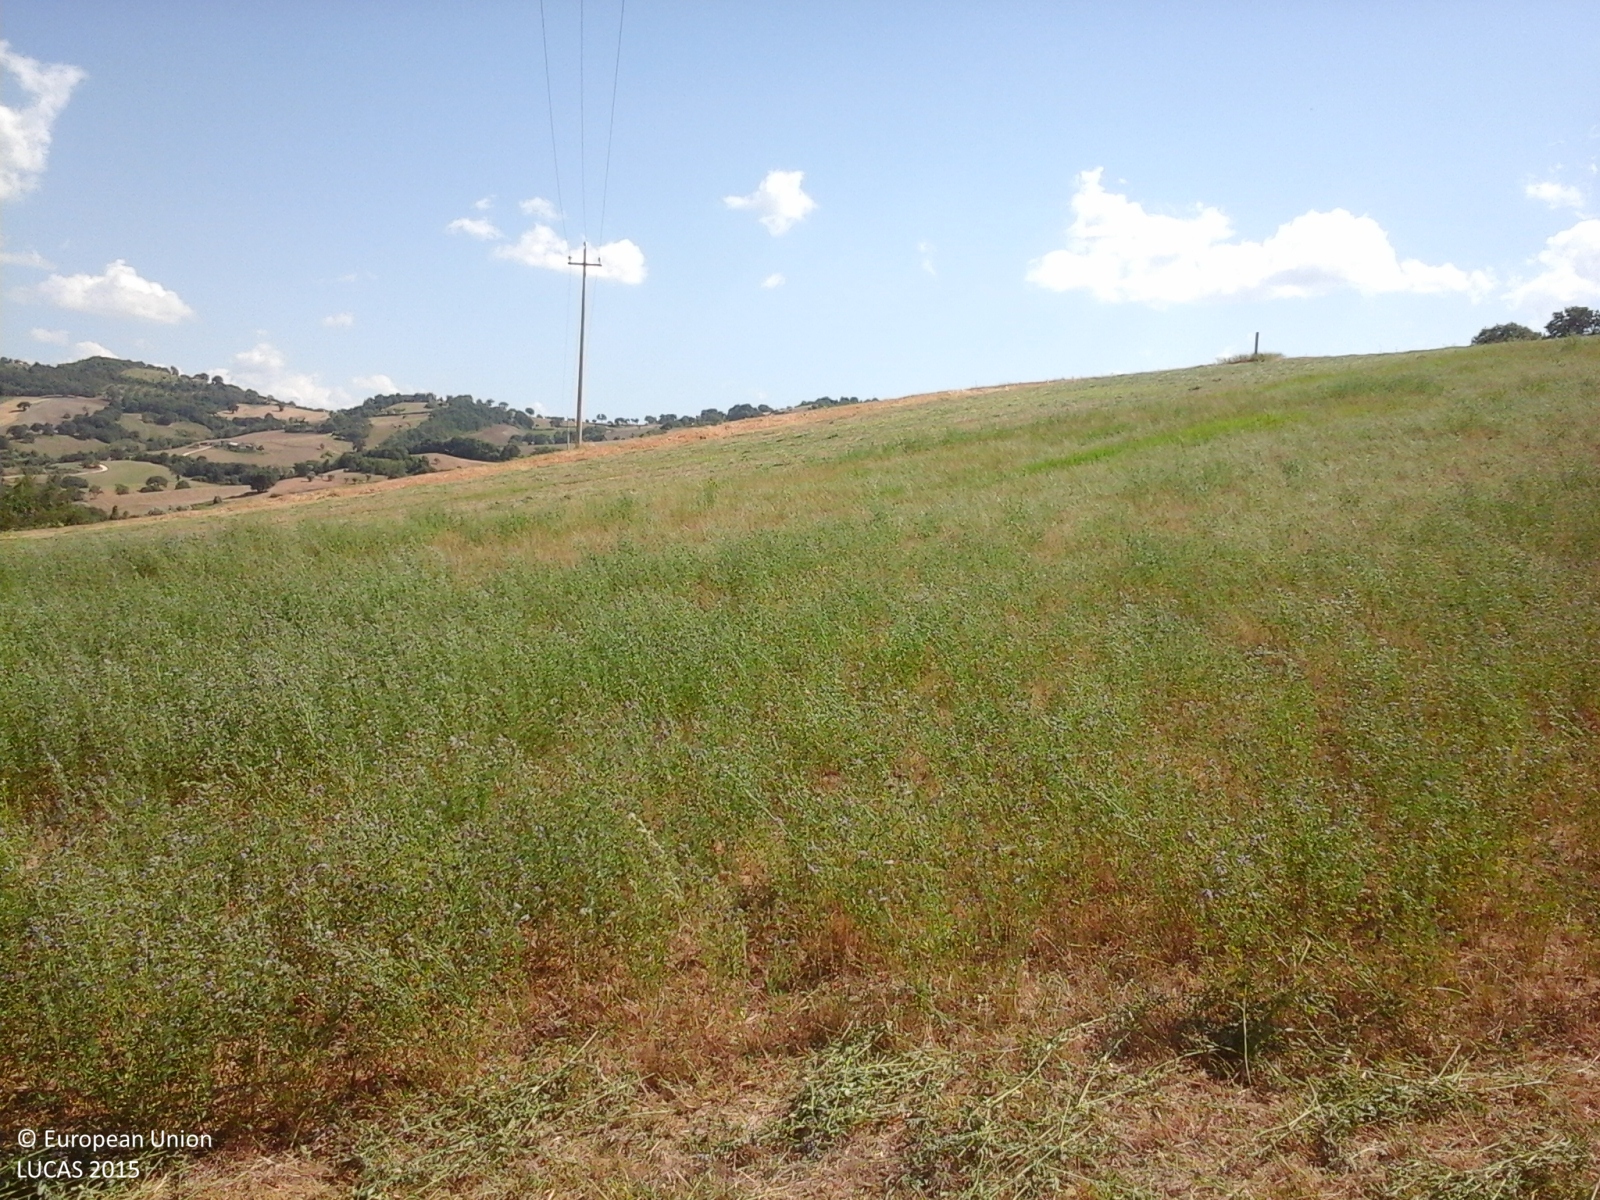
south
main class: Cropland
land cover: Lucerne
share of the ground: > 75 %
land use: Agriculture (excluding fallow land and kitchen gardens)
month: July
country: IT
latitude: 43.2350
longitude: 13.2299
